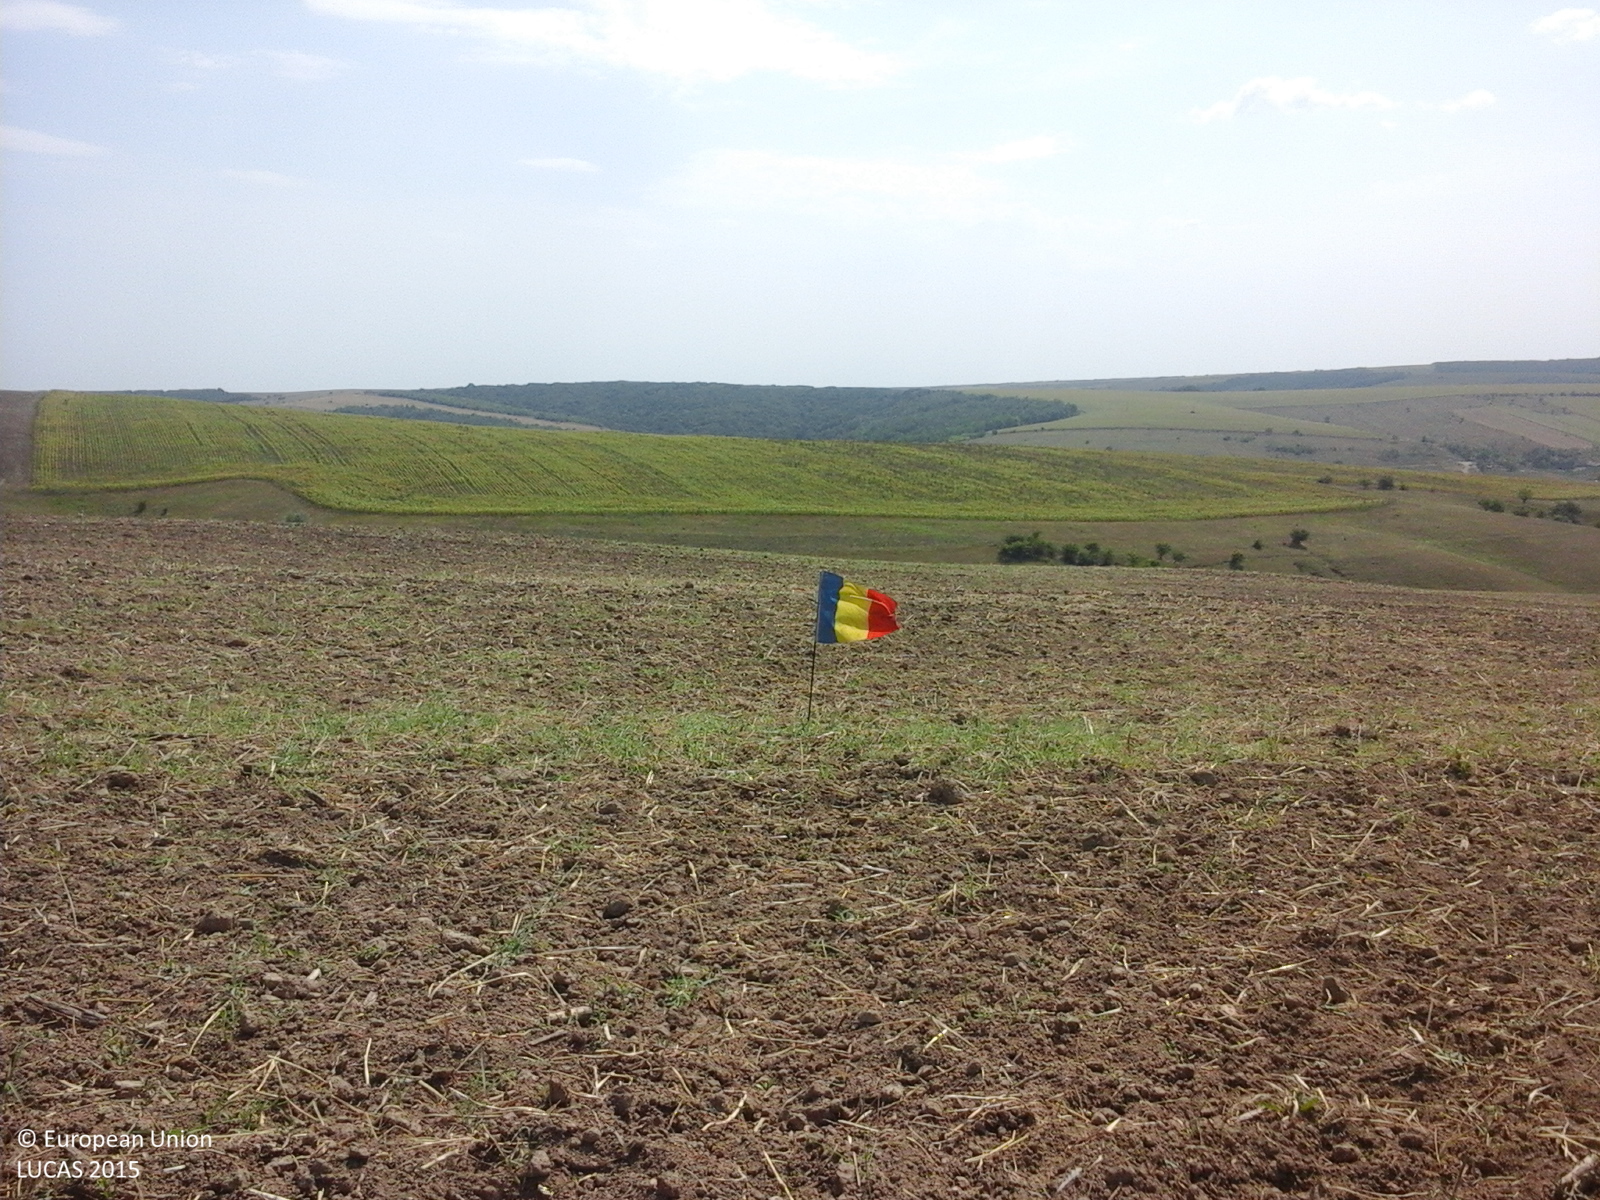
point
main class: Cropland
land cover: Common wheat
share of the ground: < 10 %
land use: Agriculture (excluding fallow land and kitchen gardens)
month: August
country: RO
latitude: 44.1669
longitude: 27.9742
